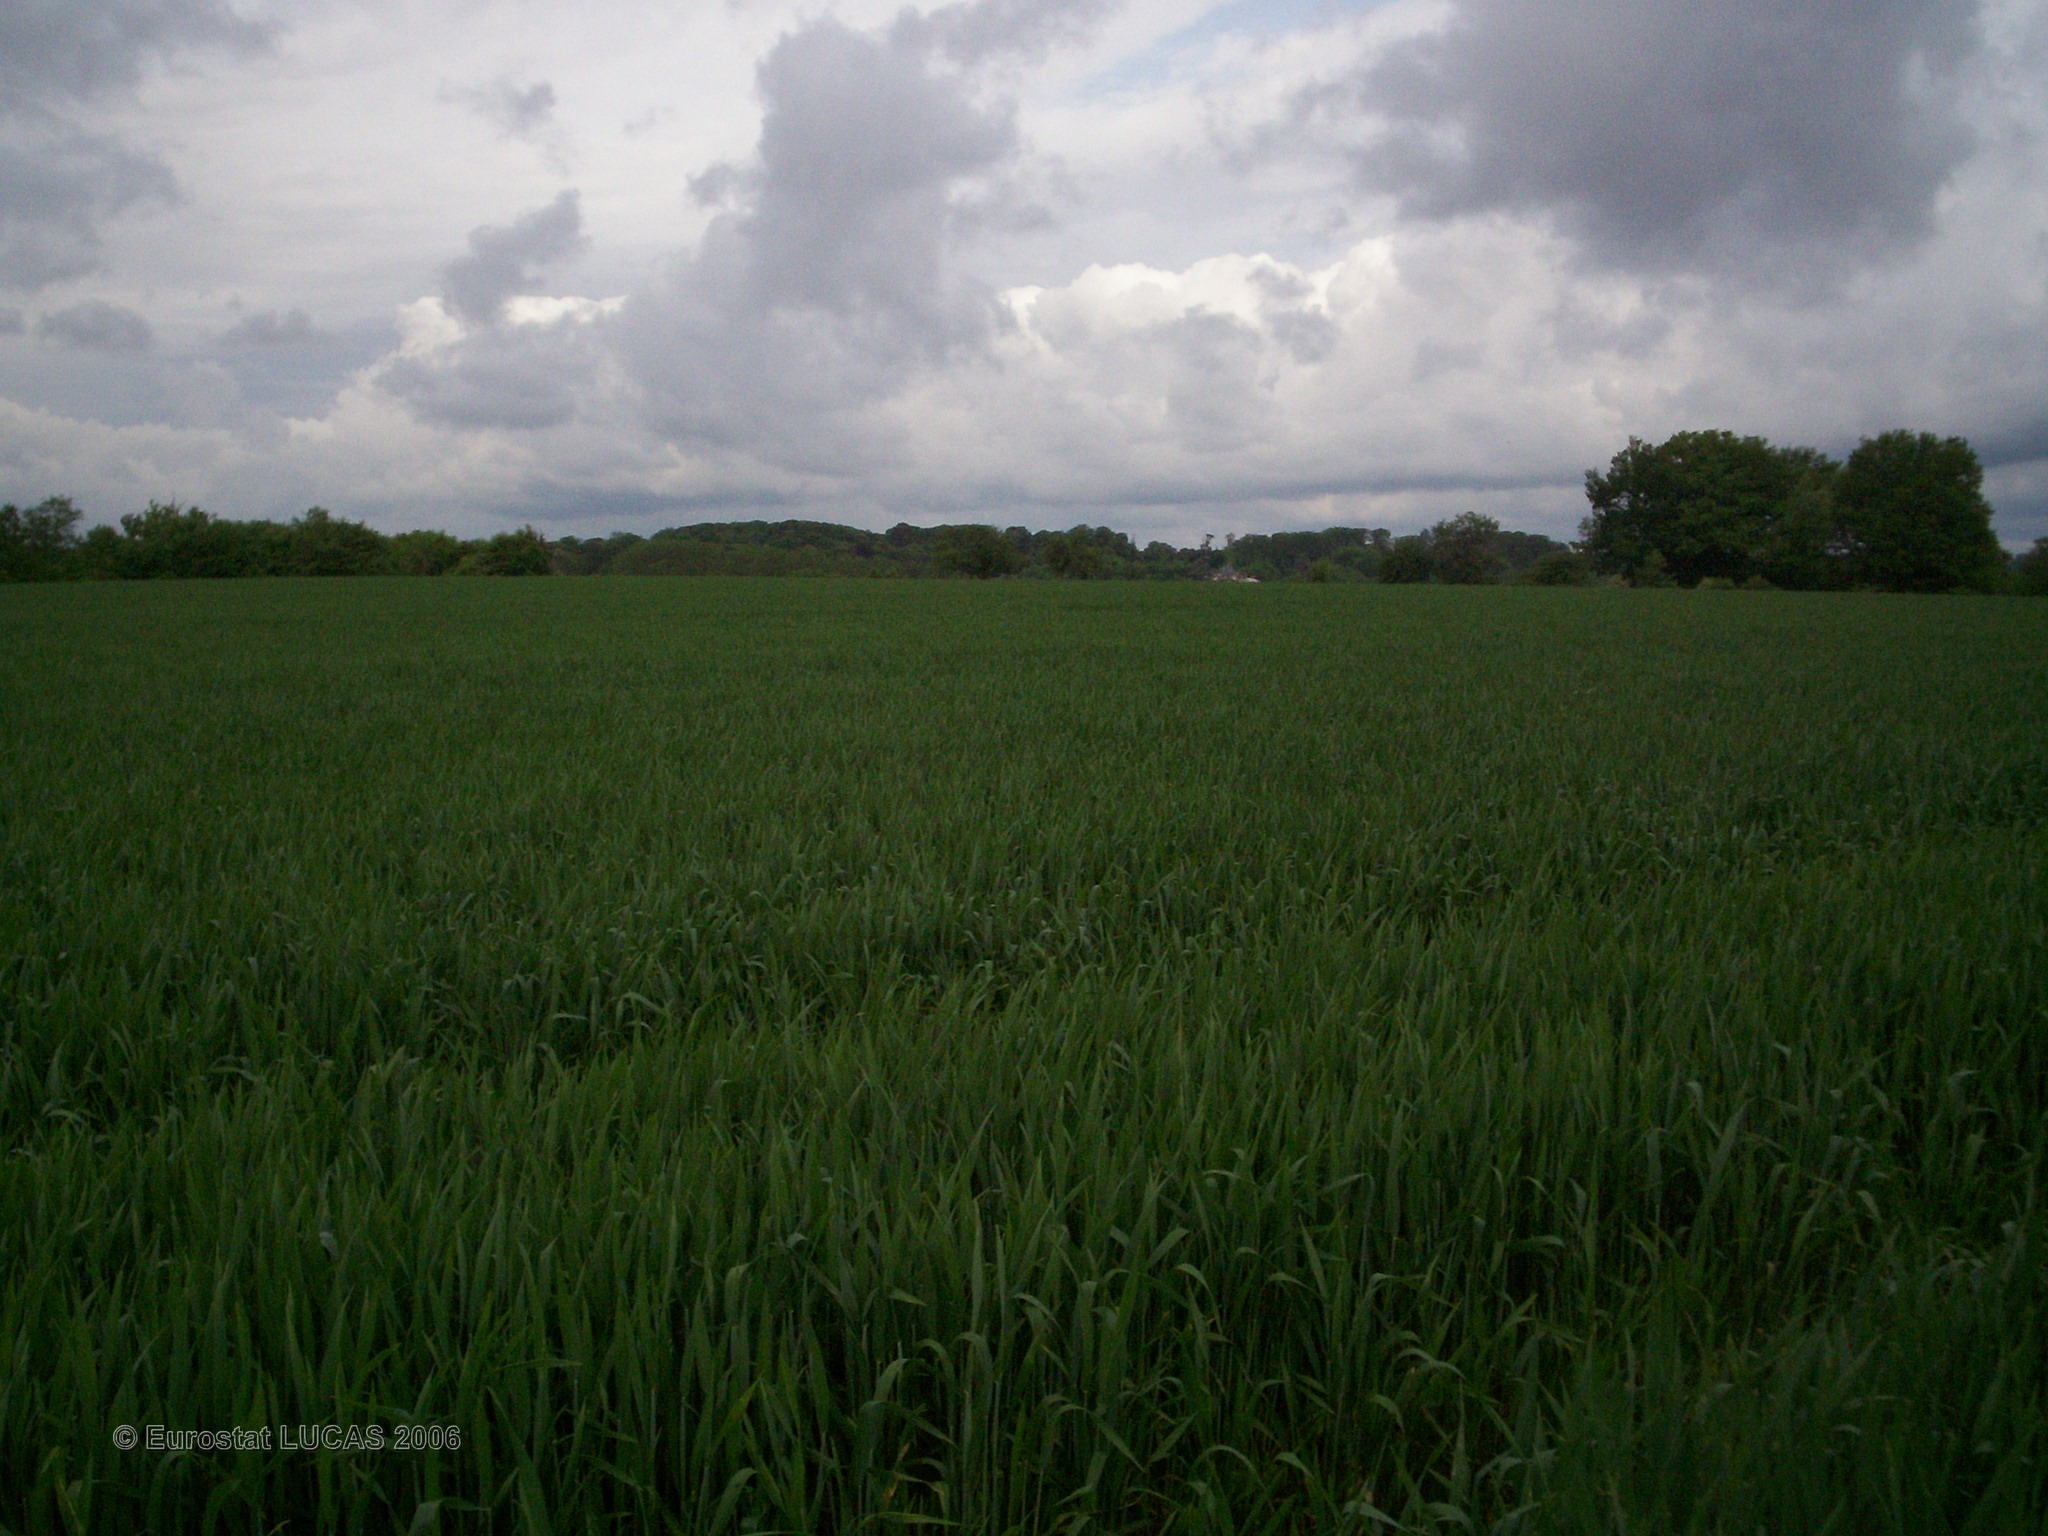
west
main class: Cropland
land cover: Common wheat
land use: Agriculture (excluding fallow land and kitchen gardens)
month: May
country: FR
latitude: 47.7244
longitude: 2.9140
